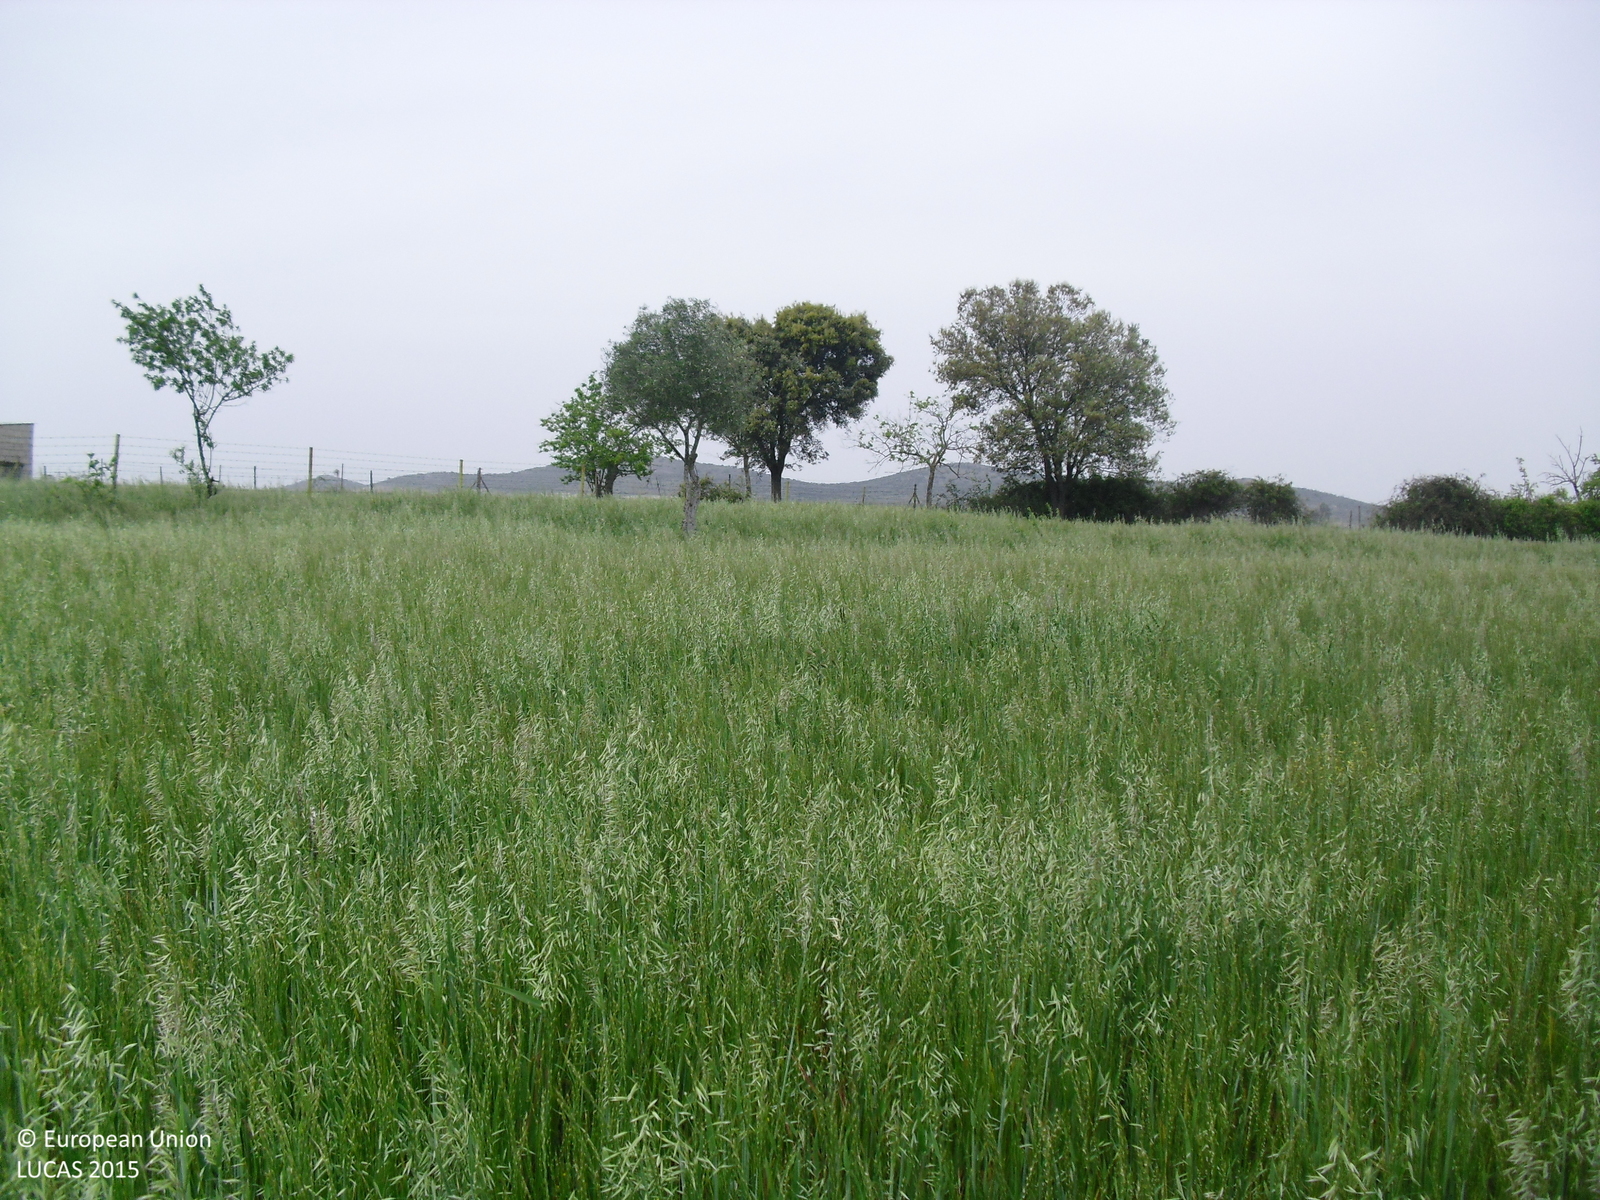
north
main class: Cropland
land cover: Oats
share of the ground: > 75 %
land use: Agriculture (excluding fallow land and kitchen gardens)
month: April
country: ES
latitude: 39.3780
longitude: -6.3766
